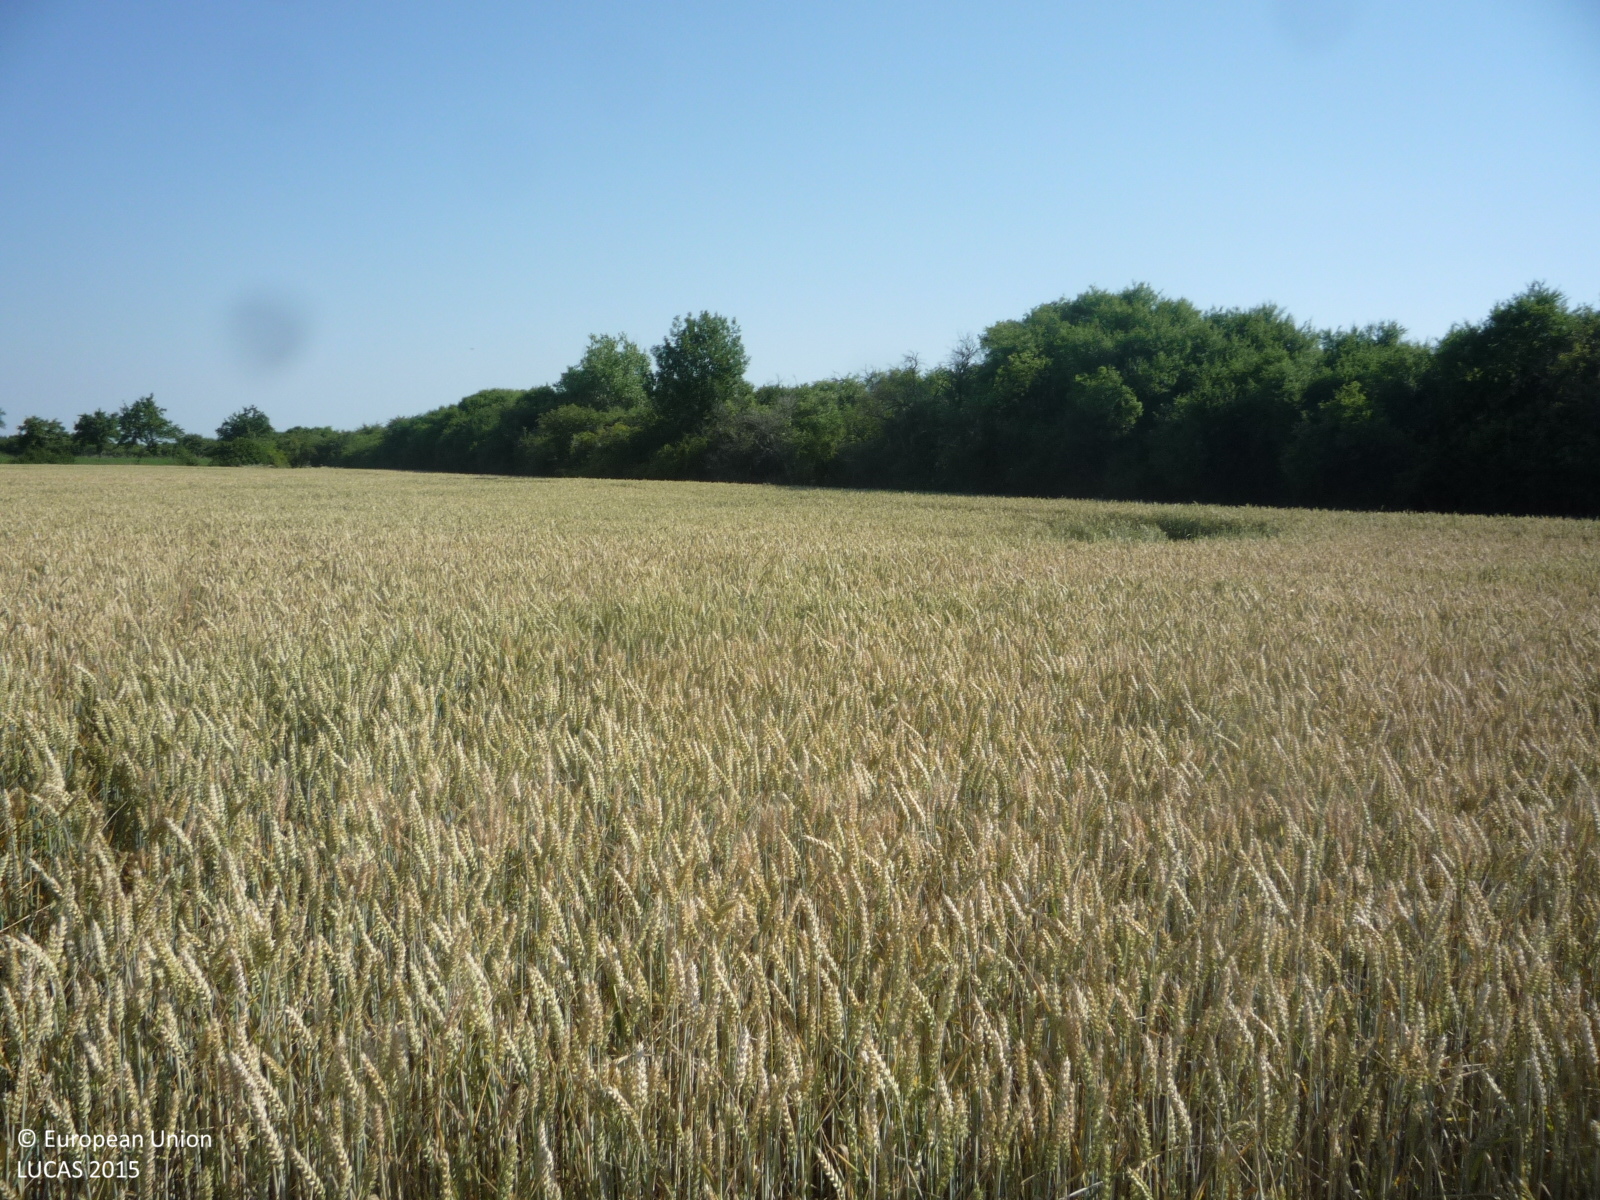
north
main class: Cropland
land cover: Common wheat
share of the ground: > 75 %
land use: Agriculture (excluding fallow land and kitchen gardens)
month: July
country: CZ
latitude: 50.1751
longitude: 15.1700
